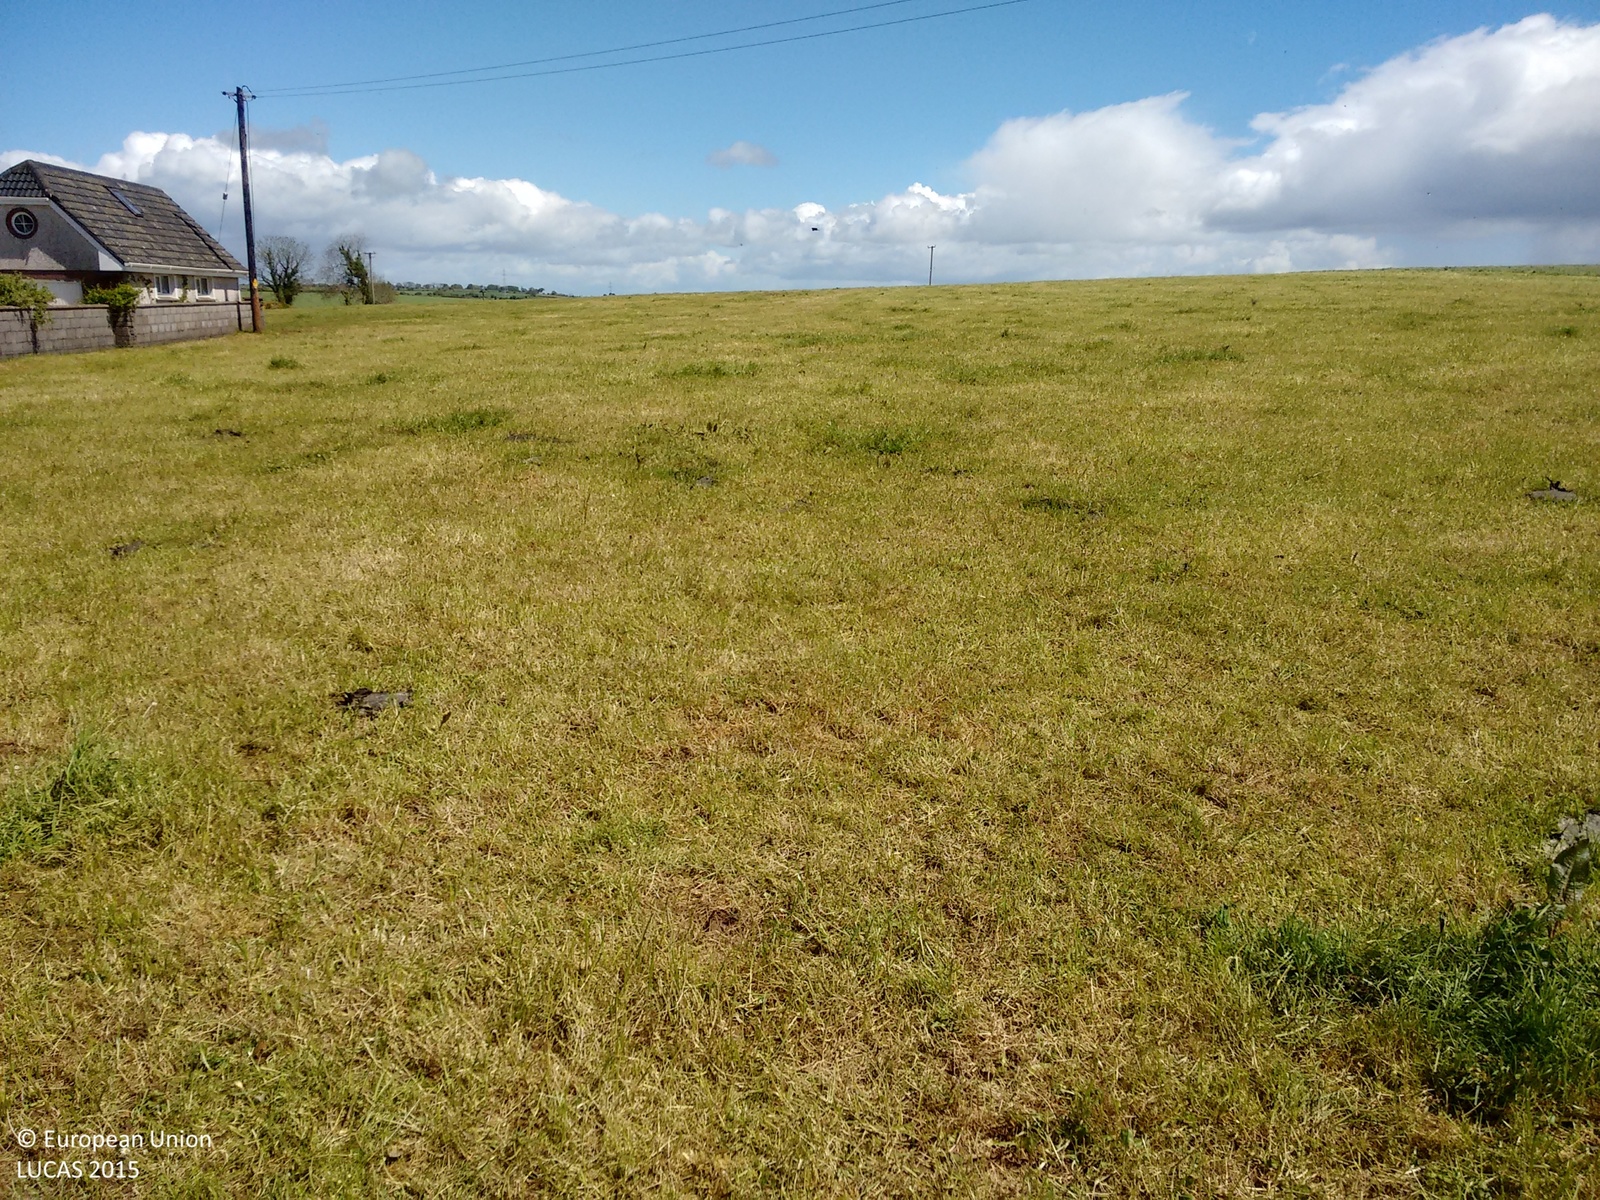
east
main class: Grassland
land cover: Grassland without tree/shrub cover
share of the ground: > 75 %
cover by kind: herbaceous plants 95 %, shrubs 5 %
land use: Agriculture (excluding fallow land and kitchen gardens)
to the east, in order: Grassland without tree/shrub cover; Electric lines; Grassland without tree/shrub cover; Electric lines; Managed hedges; Fences; Grassland without tree/shrub cover
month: May
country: IE
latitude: 51.9301
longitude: -8.3228
